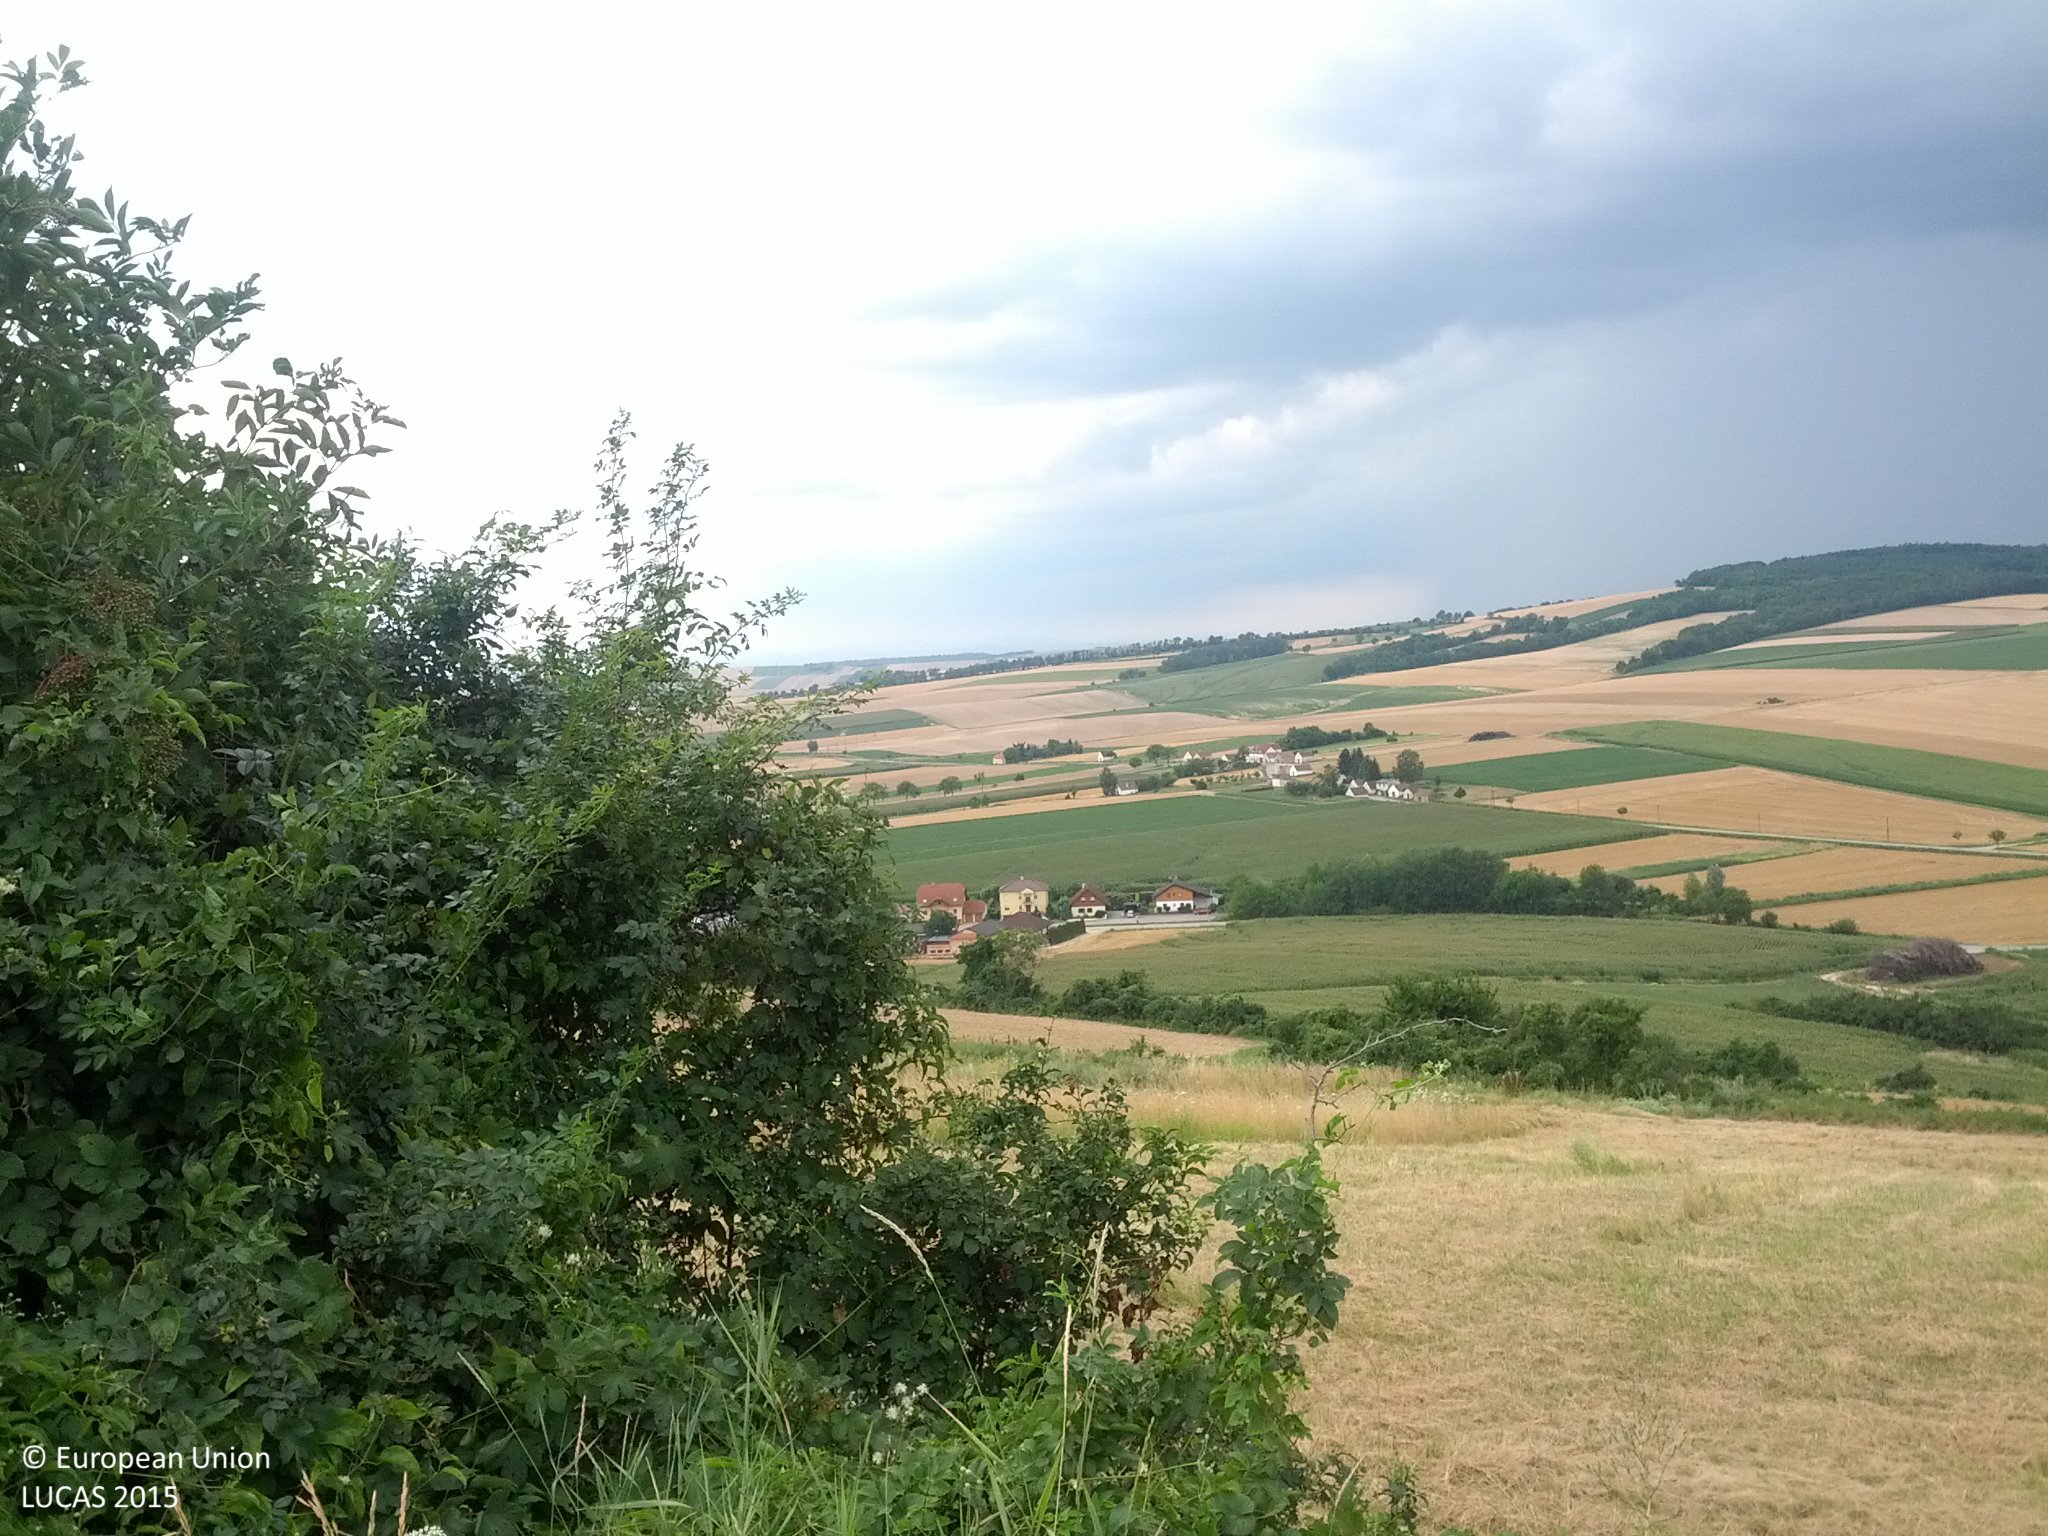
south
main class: Cropland
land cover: Other fibre and oleaginous crops
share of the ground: > 75 %
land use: Agriculture (excluding fallow land and kitchen gardens)
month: July
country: AT
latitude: 48.5202
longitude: 16.1651
